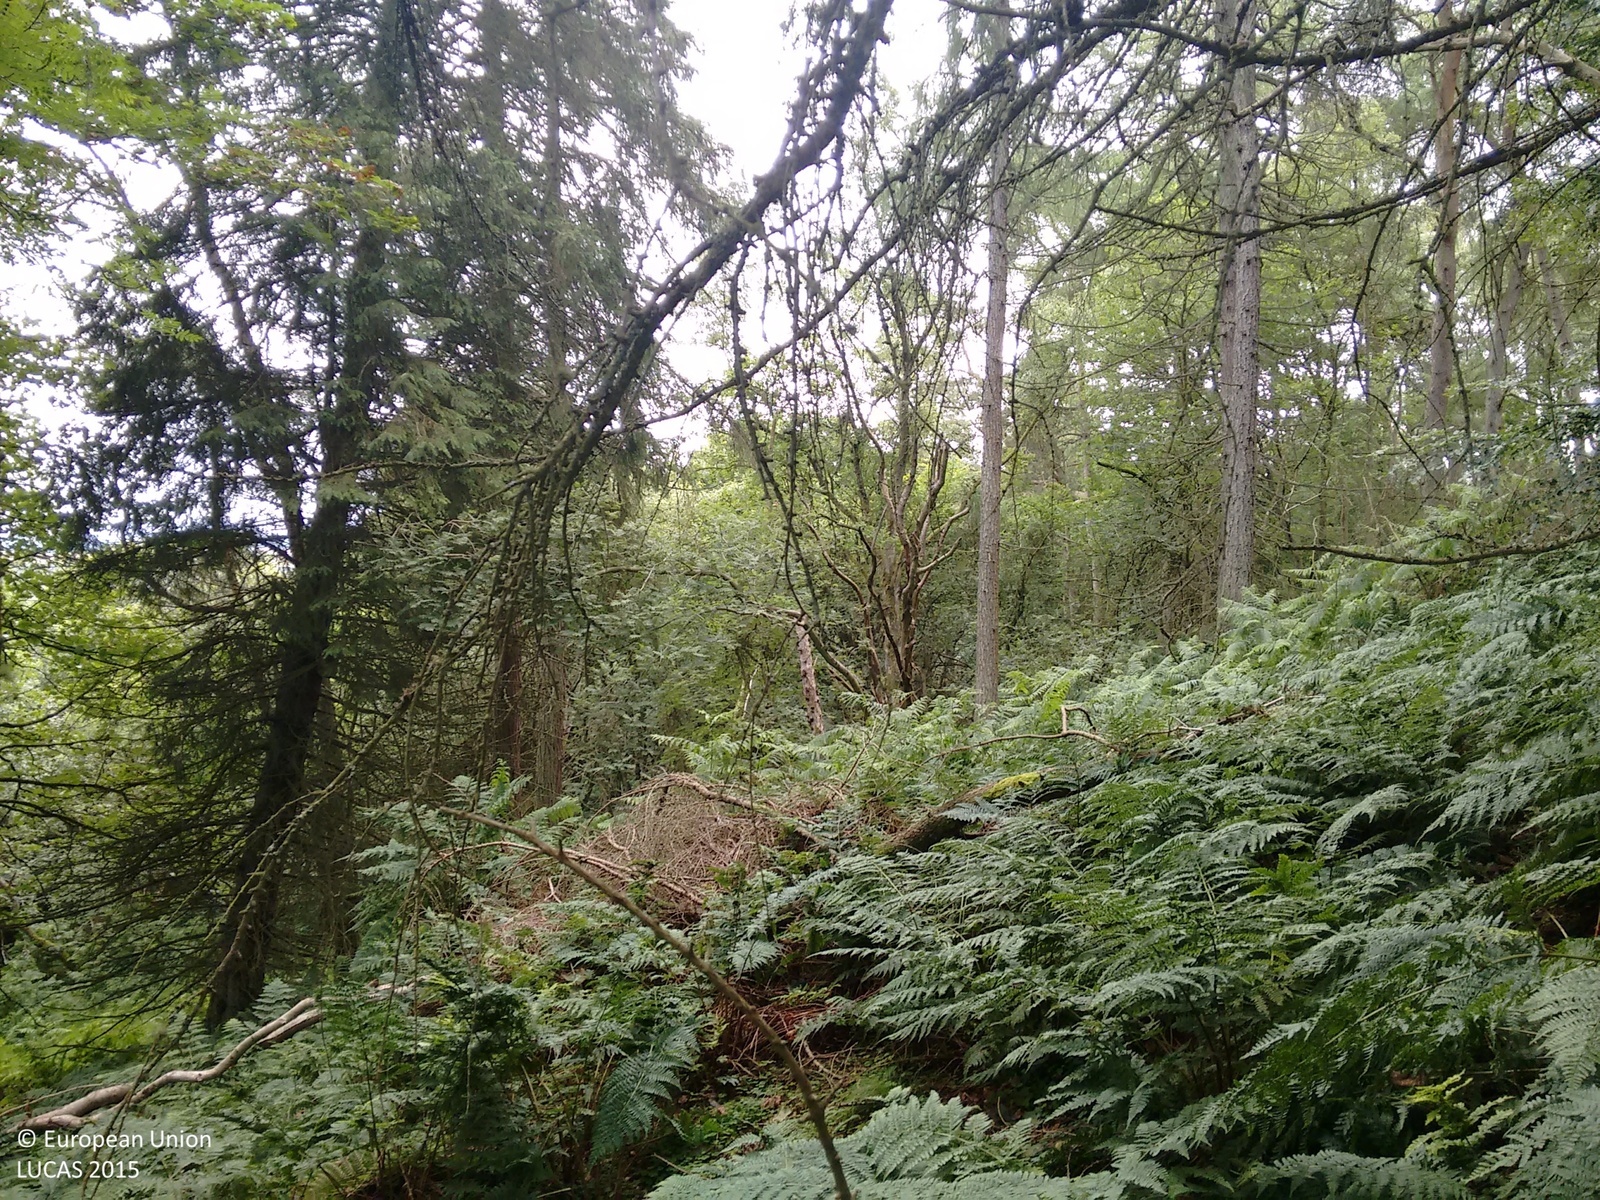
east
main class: Woodland
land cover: Other mixed woodland
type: acidophilous oak and oak-birch forest
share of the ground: > 75 %
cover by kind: coniferous forest trees 60 %, broadleaved forest trees 35 %, herbaceous plants 5 %
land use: Forestry
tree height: > 5 m
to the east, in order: Other mixed woodland
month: July
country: GB
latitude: 56.3860
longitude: -2.9416
